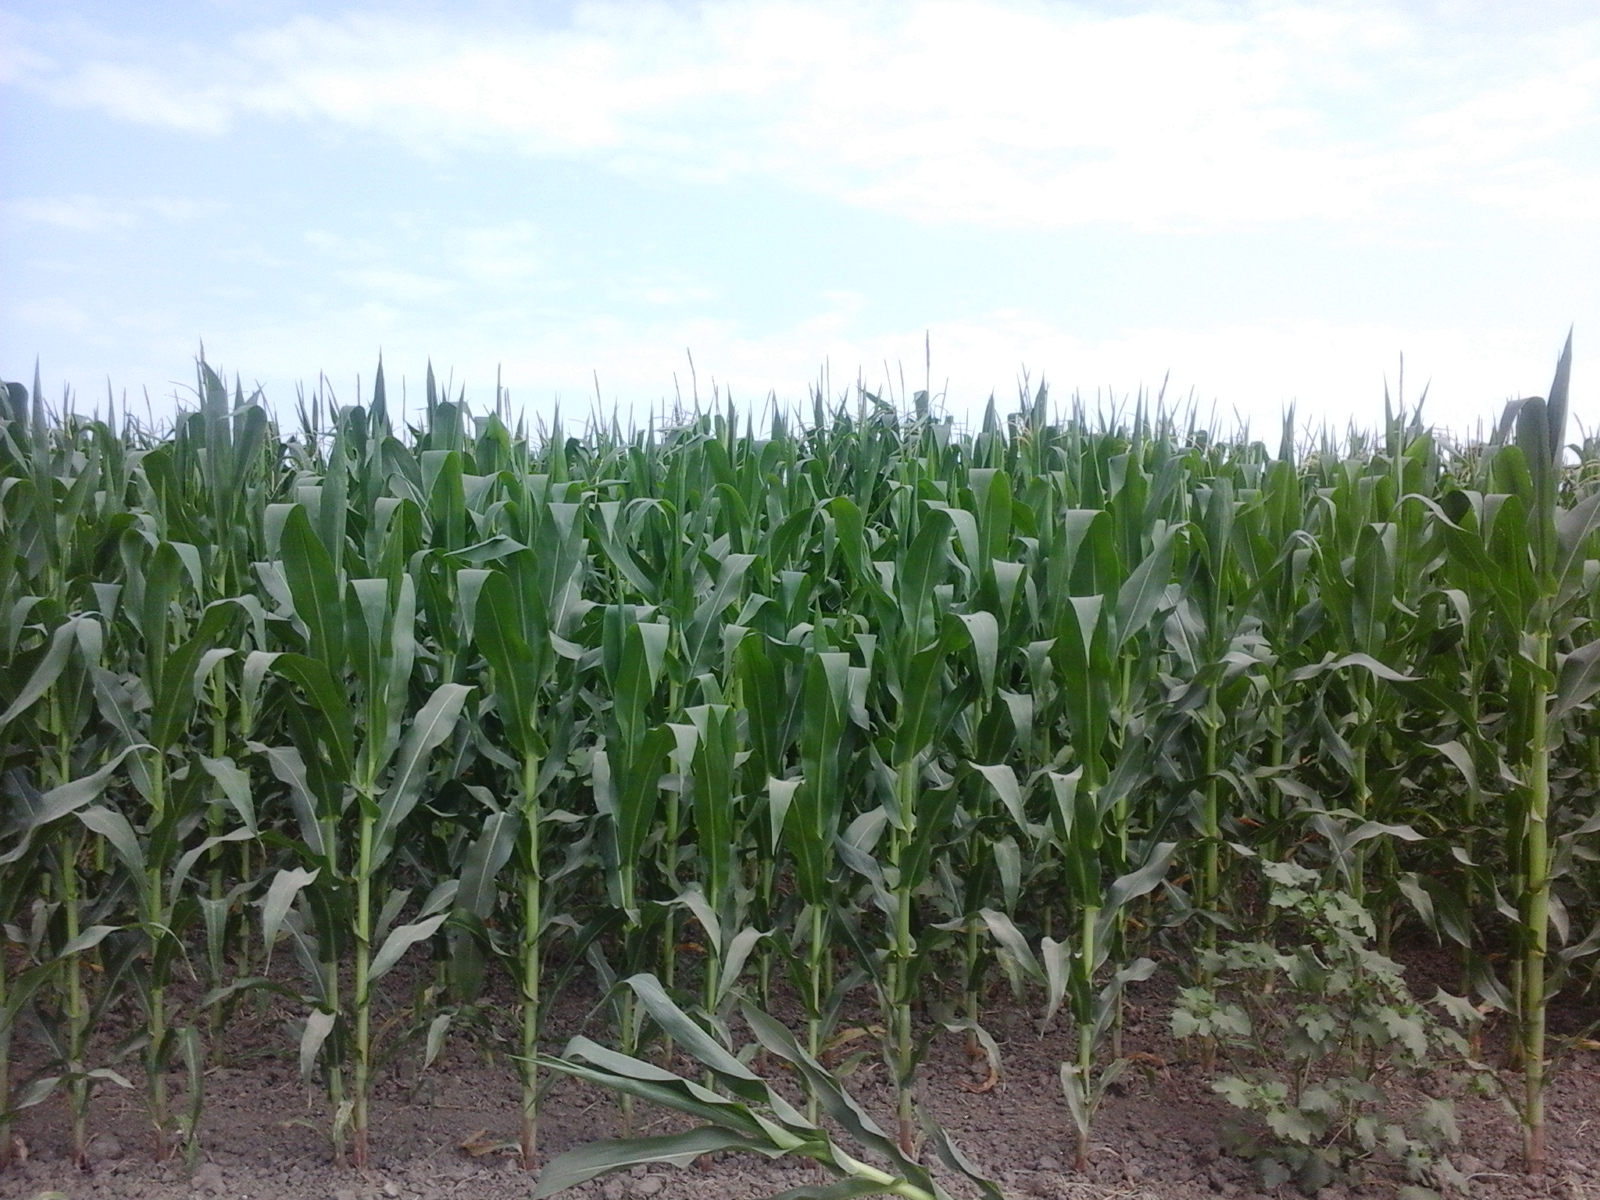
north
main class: Cropland
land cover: Maize
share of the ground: > 75 %
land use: Agriculture (excluding fallow land and kitchen gardens)
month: July
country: RO
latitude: 44.4677
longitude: 28.0461
